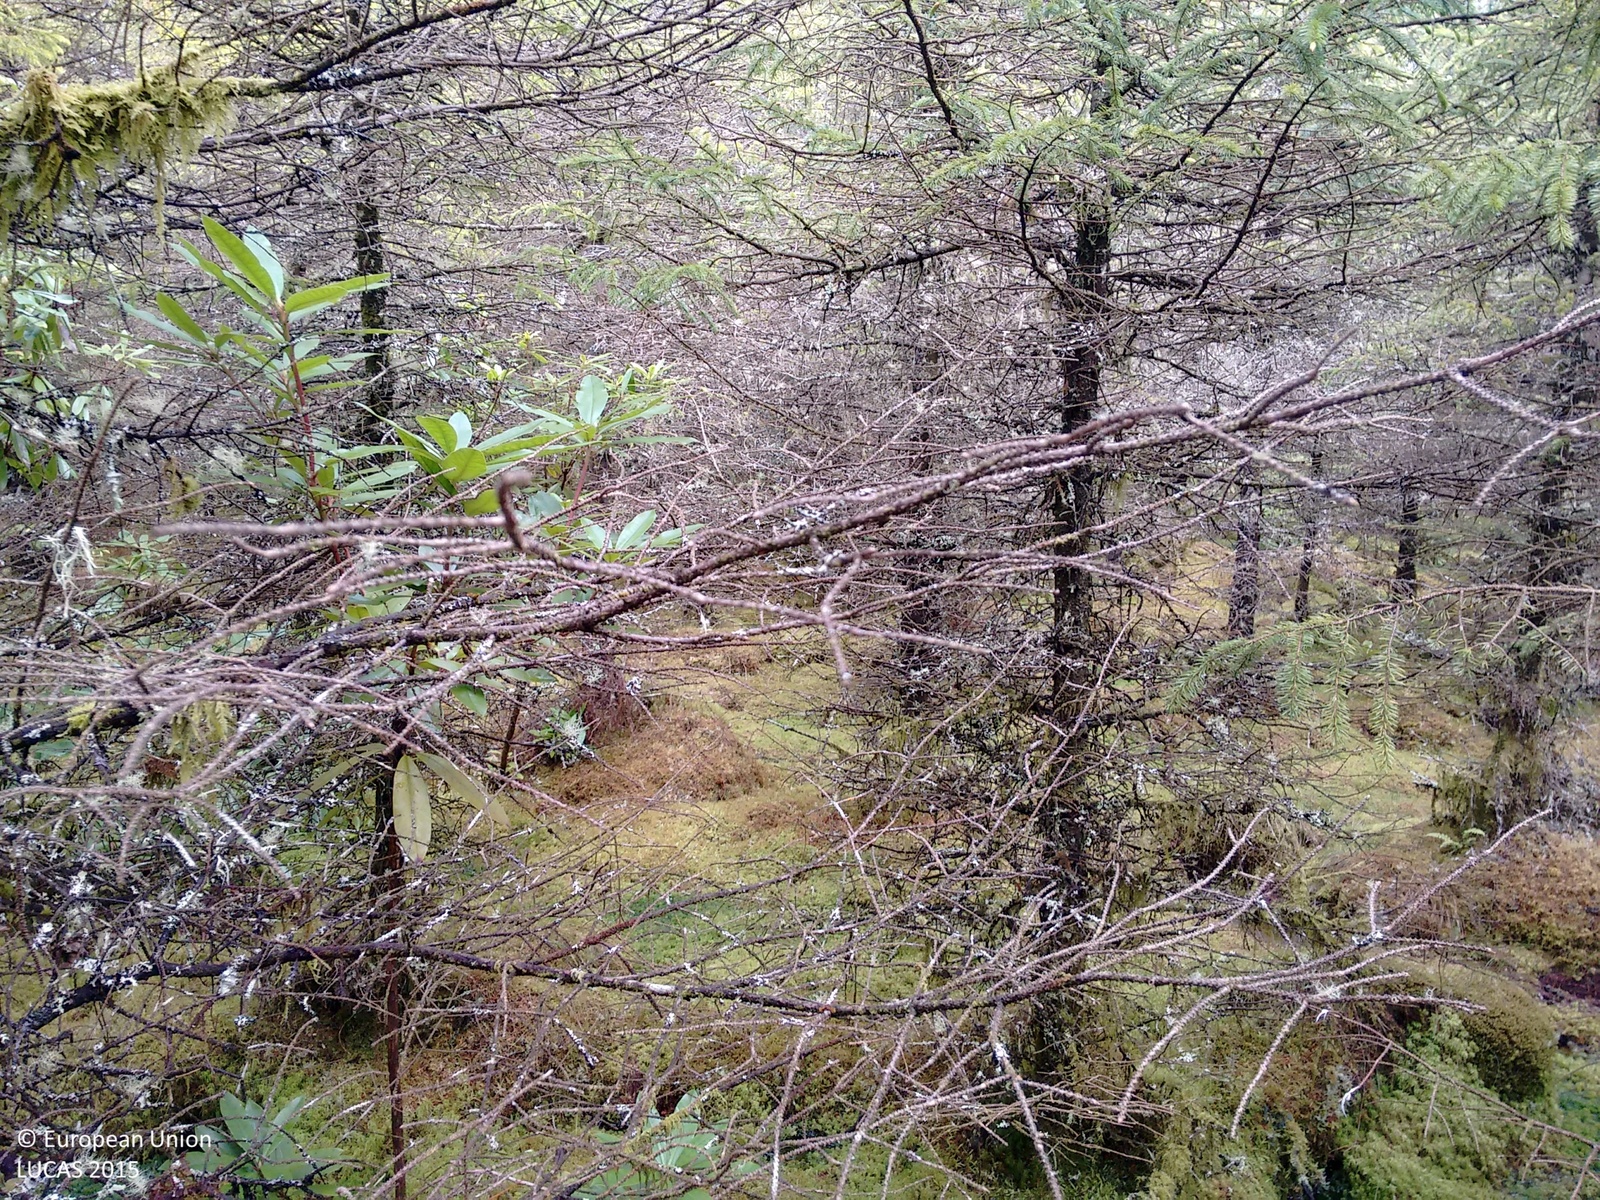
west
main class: Woodland
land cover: Spruce dominated coniferous woodland
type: exotic forest
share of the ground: > 75 %
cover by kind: coniferous forest trees 100 %
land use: Forestry
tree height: > 5 m
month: June
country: GB
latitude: 56.0991
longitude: -5.5068
